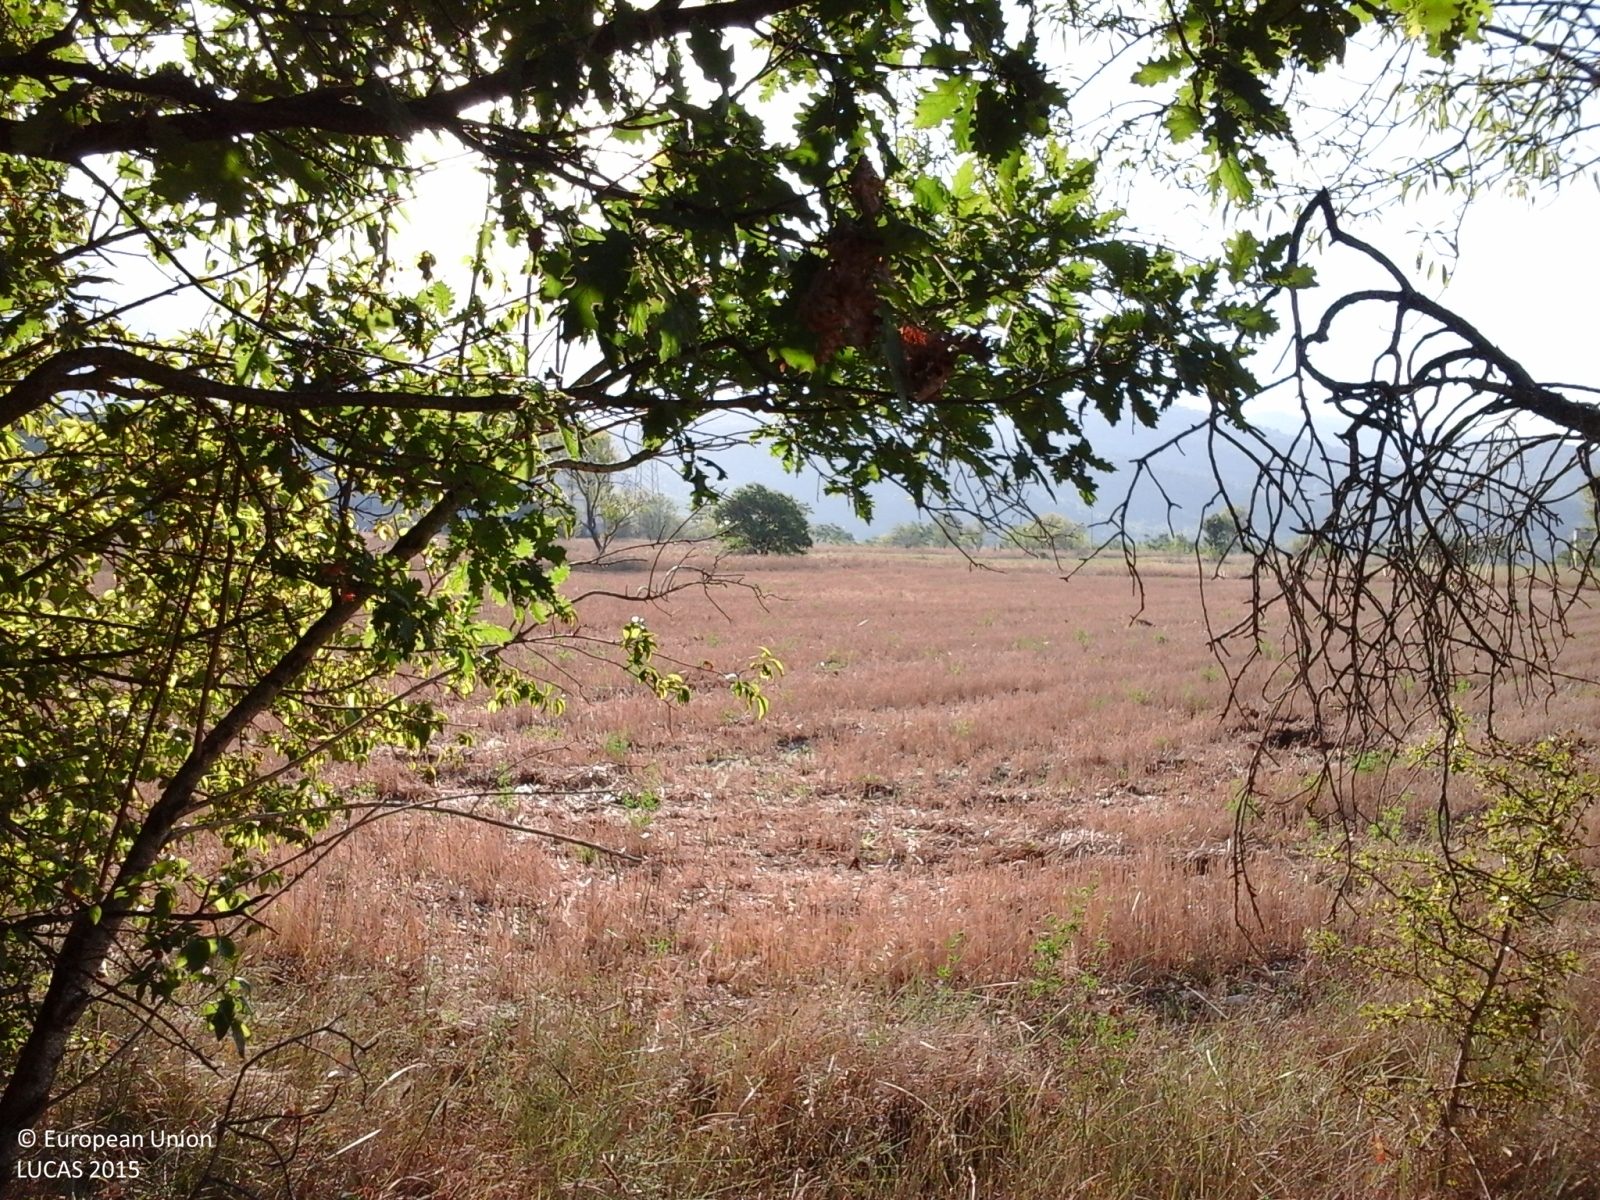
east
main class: Grassland
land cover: Spontaneously vegetated surfaces
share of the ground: > 75 %
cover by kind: herbaceous plants 100 %
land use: Agriculture (excluding fallow land and kitchen gardens)
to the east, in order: Spontaneously vegetated surfaces; Abandoned hedges; Fences; Rock outcrops; Lucerne; Dry stone walls; Grassland without tree/shrub cover; Single bushes/trees; Grassland without tree/shrub cover; Electric lines; Grassland without tree/shrub cover
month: August
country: IT
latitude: 42.1674
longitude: 13.2693
